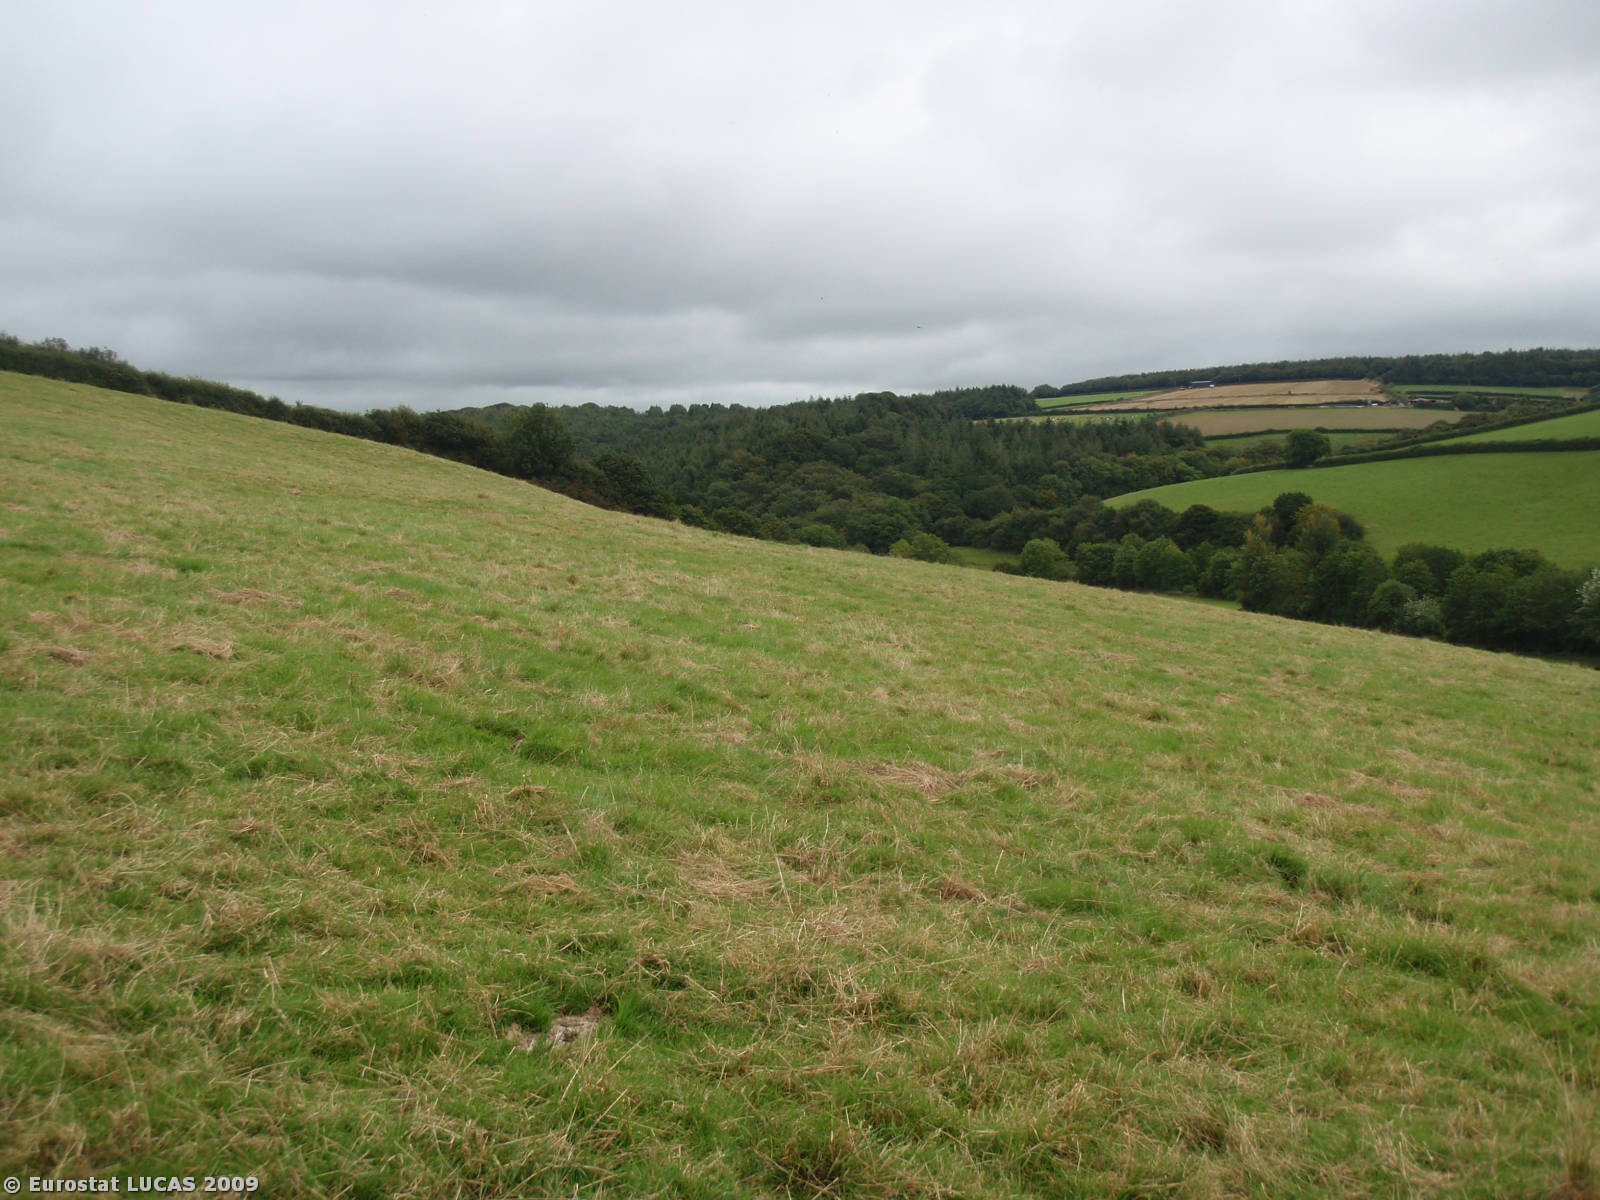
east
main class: Grassland
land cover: Grassland without tree/shrub cover
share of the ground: > 75 %
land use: Agriculture (excluding fallow land and kitchen gardens)
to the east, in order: Grassland without tree/shrub cover; Electric lines; Grassland without tree/shrub cover
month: August
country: GB
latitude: 50.5714
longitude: -4.3190
